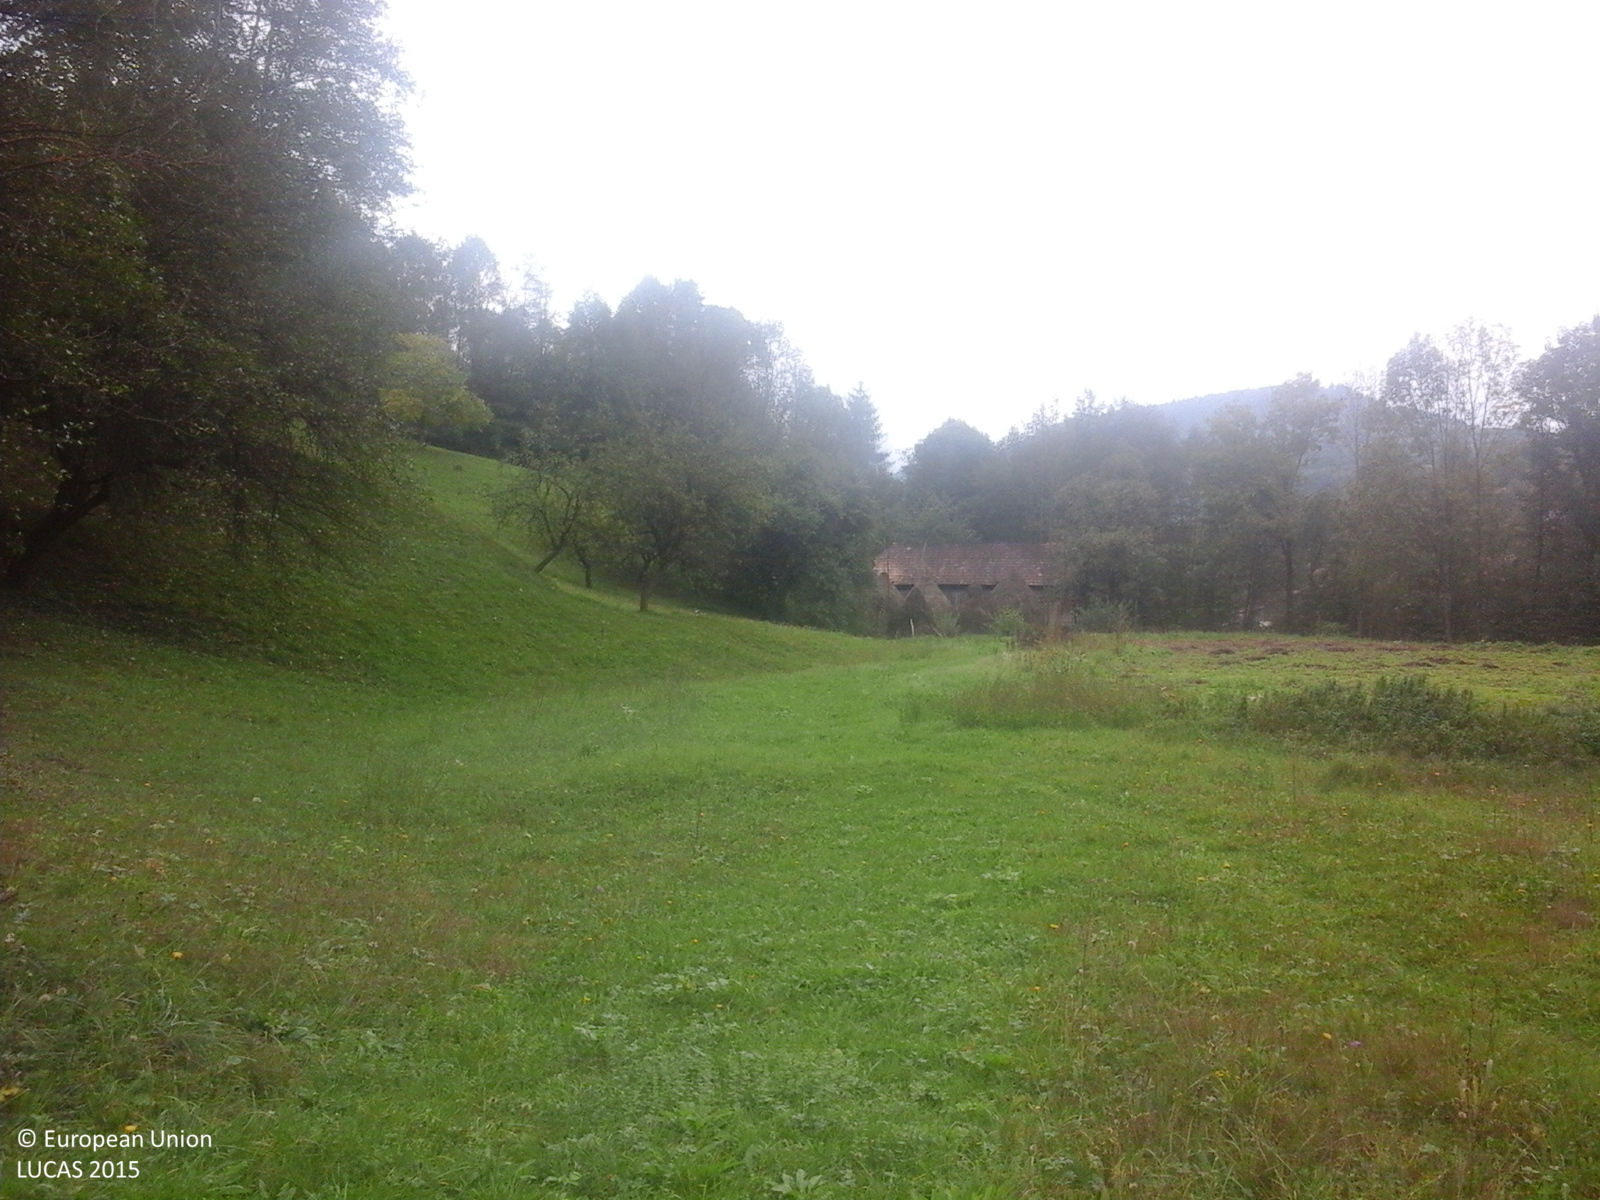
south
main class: Grassland
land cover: Grassland without tree/shrub cover
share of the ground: > 75 %
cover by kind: herbaceous plants 100 %
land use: Agriculture (excluding fallow land and kitchen gardens)
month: October
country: RO
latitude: 46.3530
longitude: 23.1734
